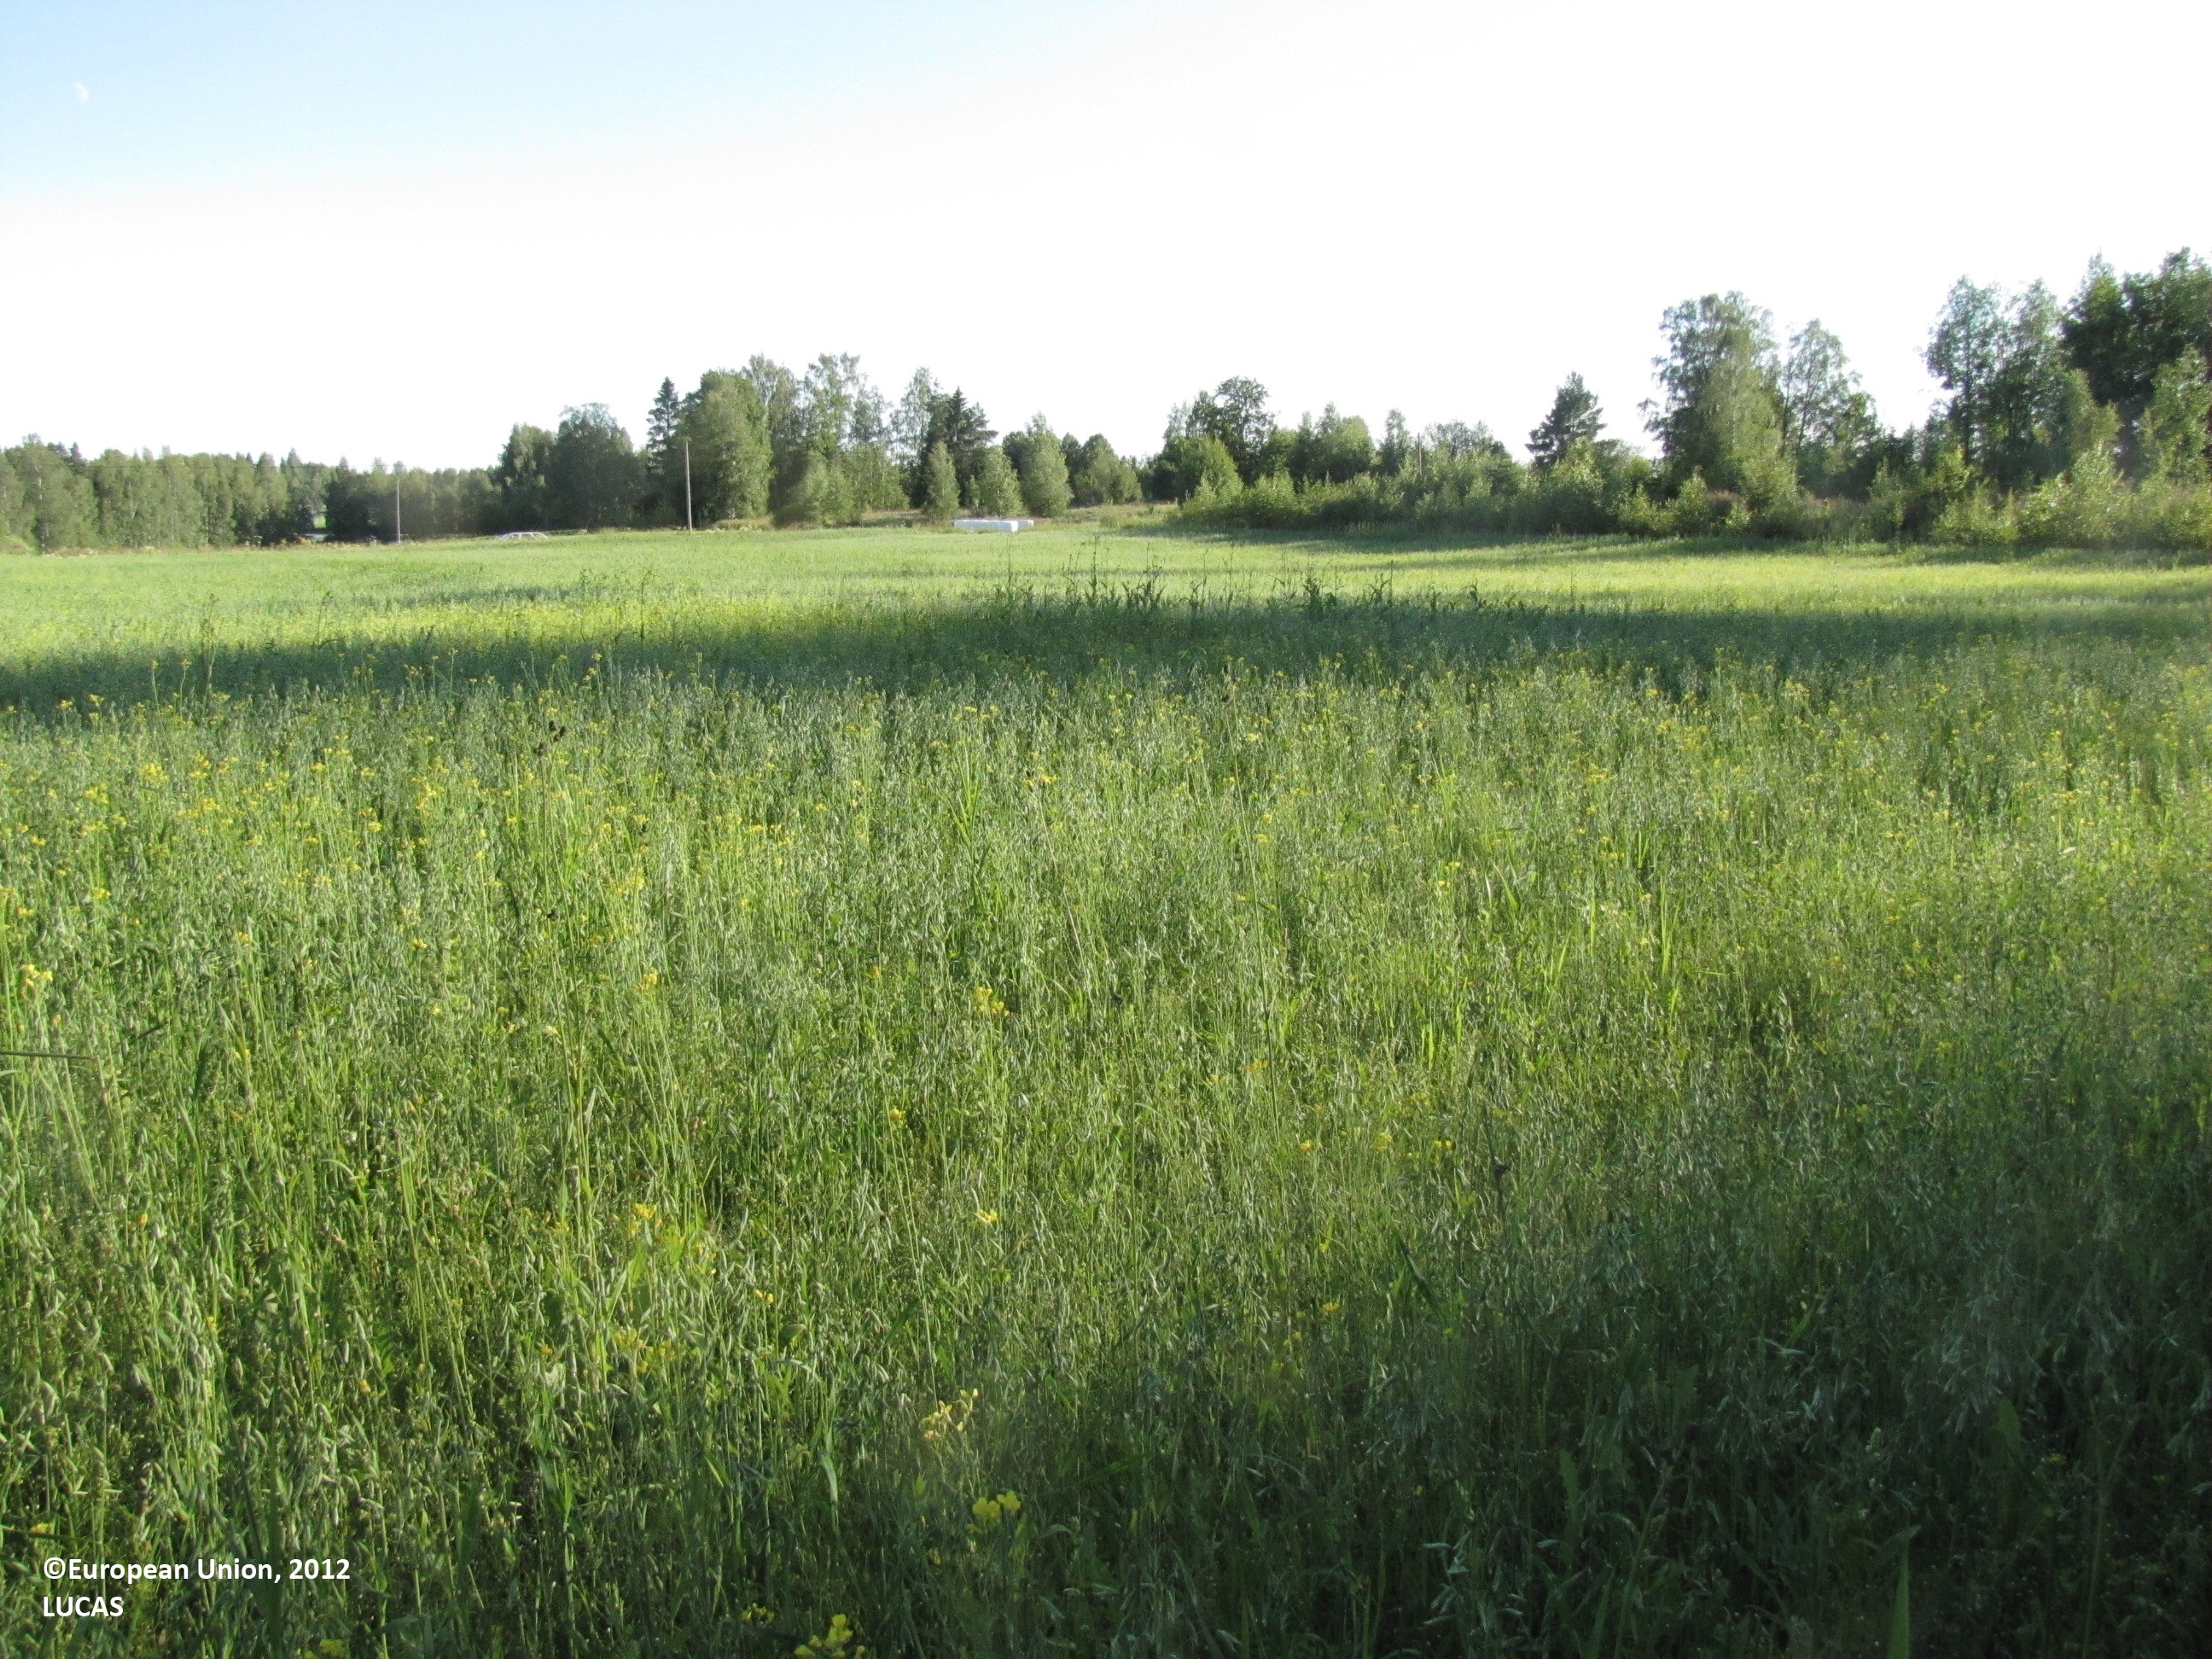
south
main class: Cropland
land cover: Other leguminous and mixtures for fodder
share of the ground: > 75 %
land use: Agriculture (excluding fallow land and kitchen gardens)
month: July
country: FI
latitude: 62.1153
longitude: 23.0424
